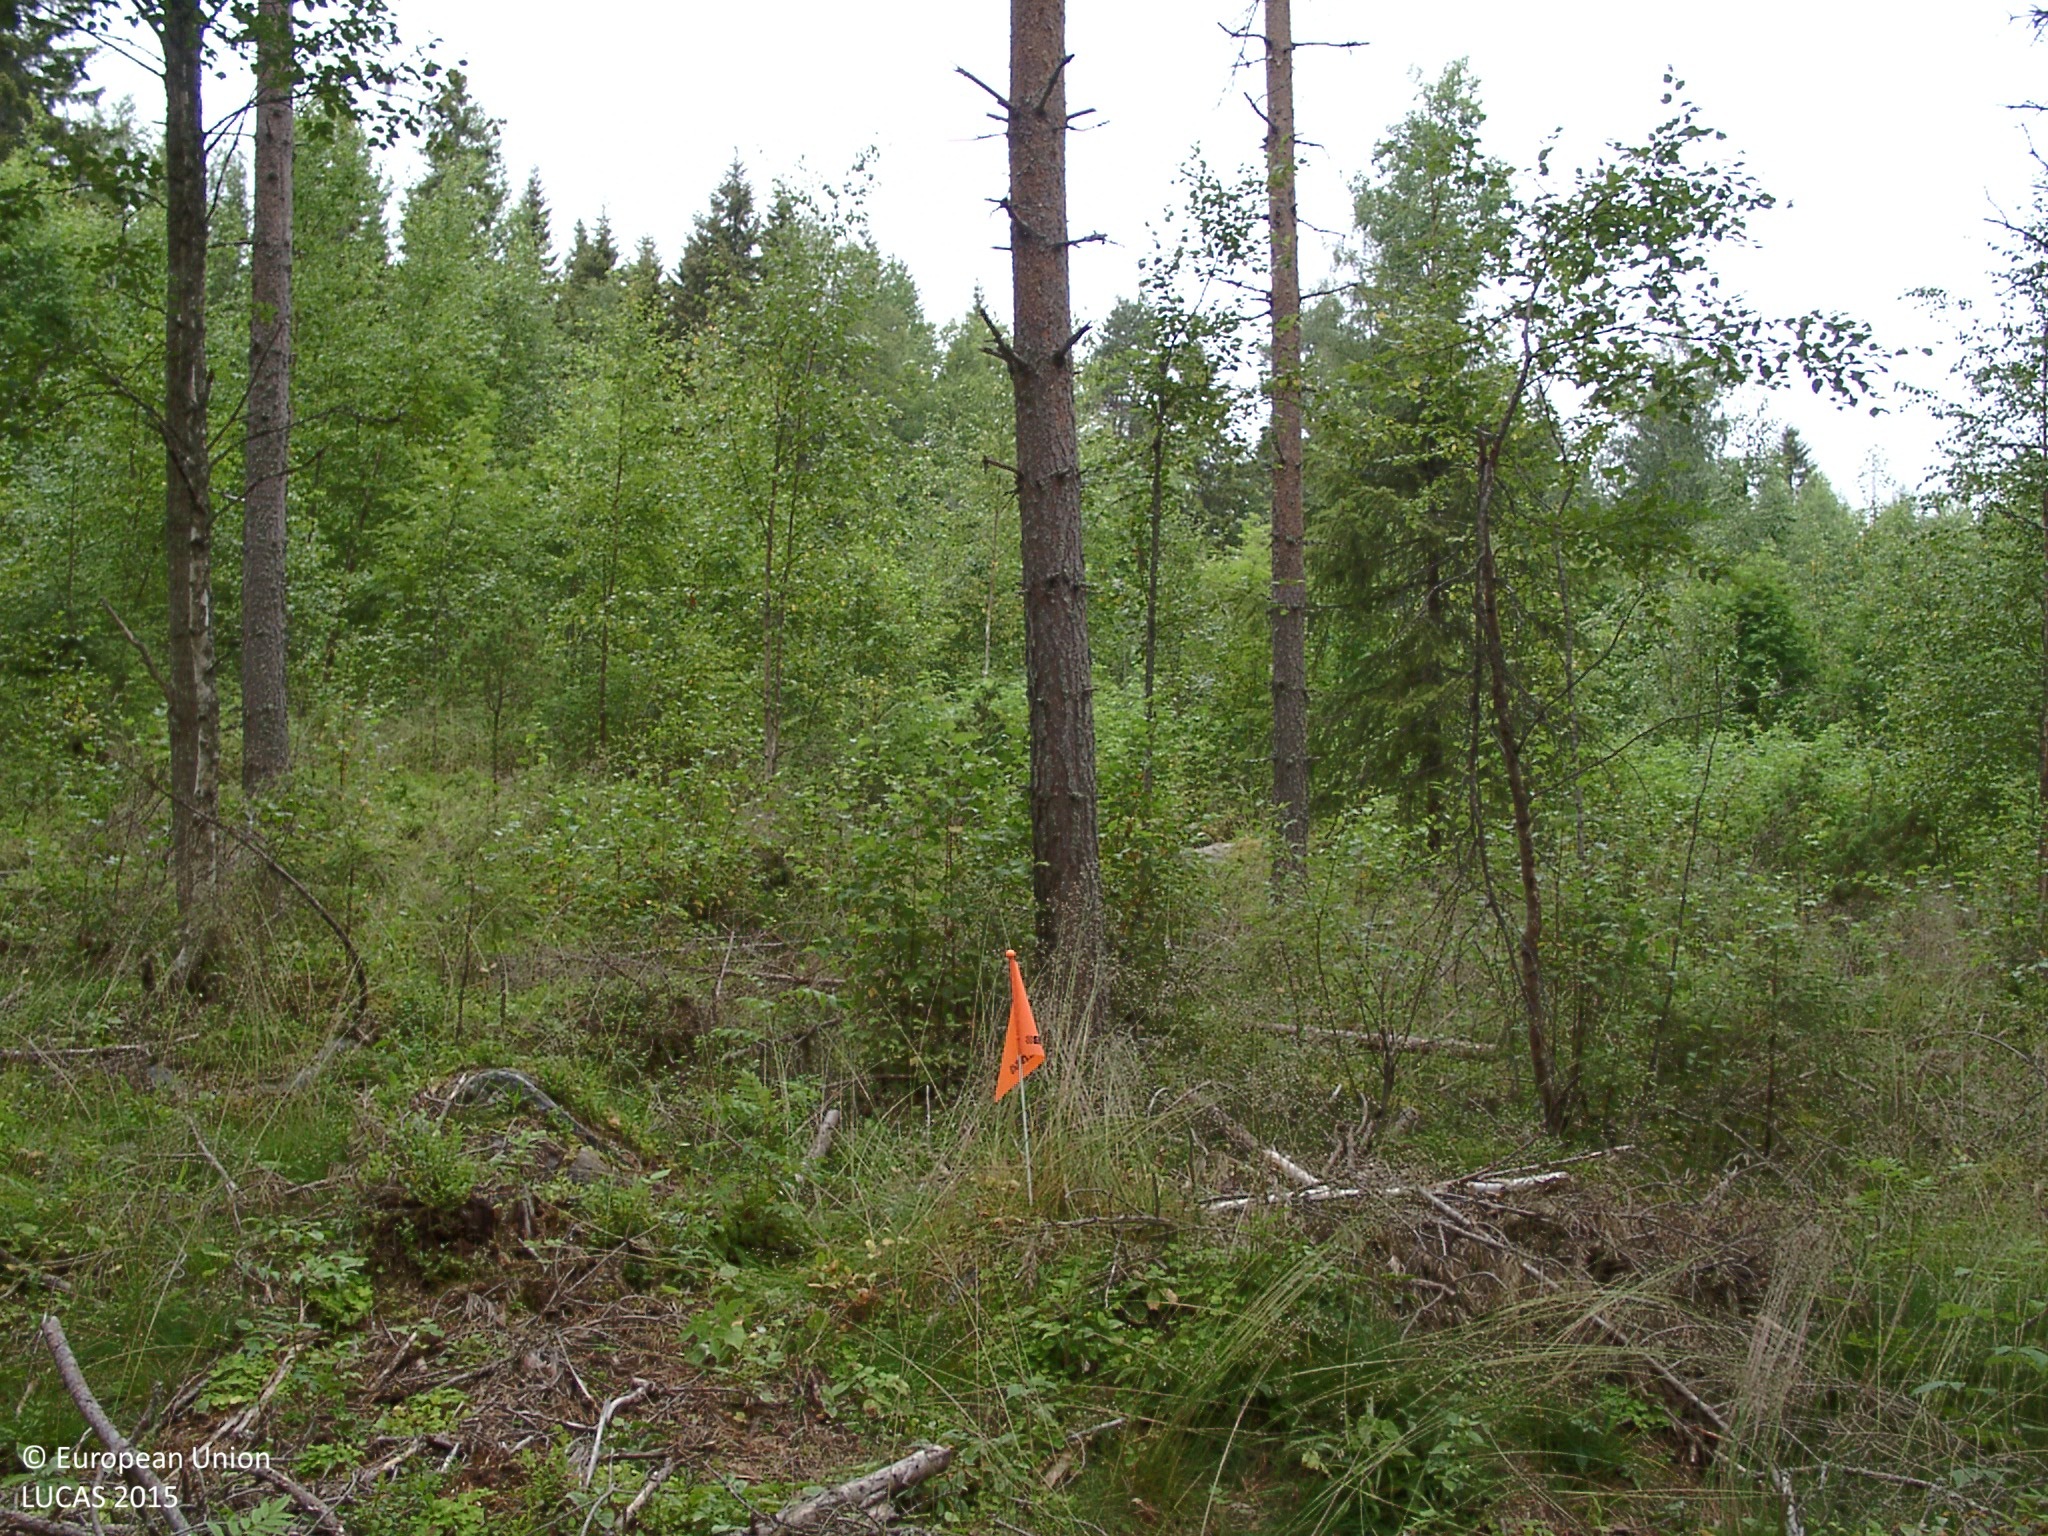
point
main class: Woodland
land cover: Pine dominated mixed woodland
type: boreal forest
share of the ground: 50 - 75 %
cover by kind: coniferous forest trees 45 %, broadleaved forest trees 20 %, shrubs 15 %, herbaceous plants 10 %, lichens and mosses 5 %
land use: Forestry
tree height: > 5 m
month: August
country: FI
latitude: 62.8553
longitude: 24.5672
